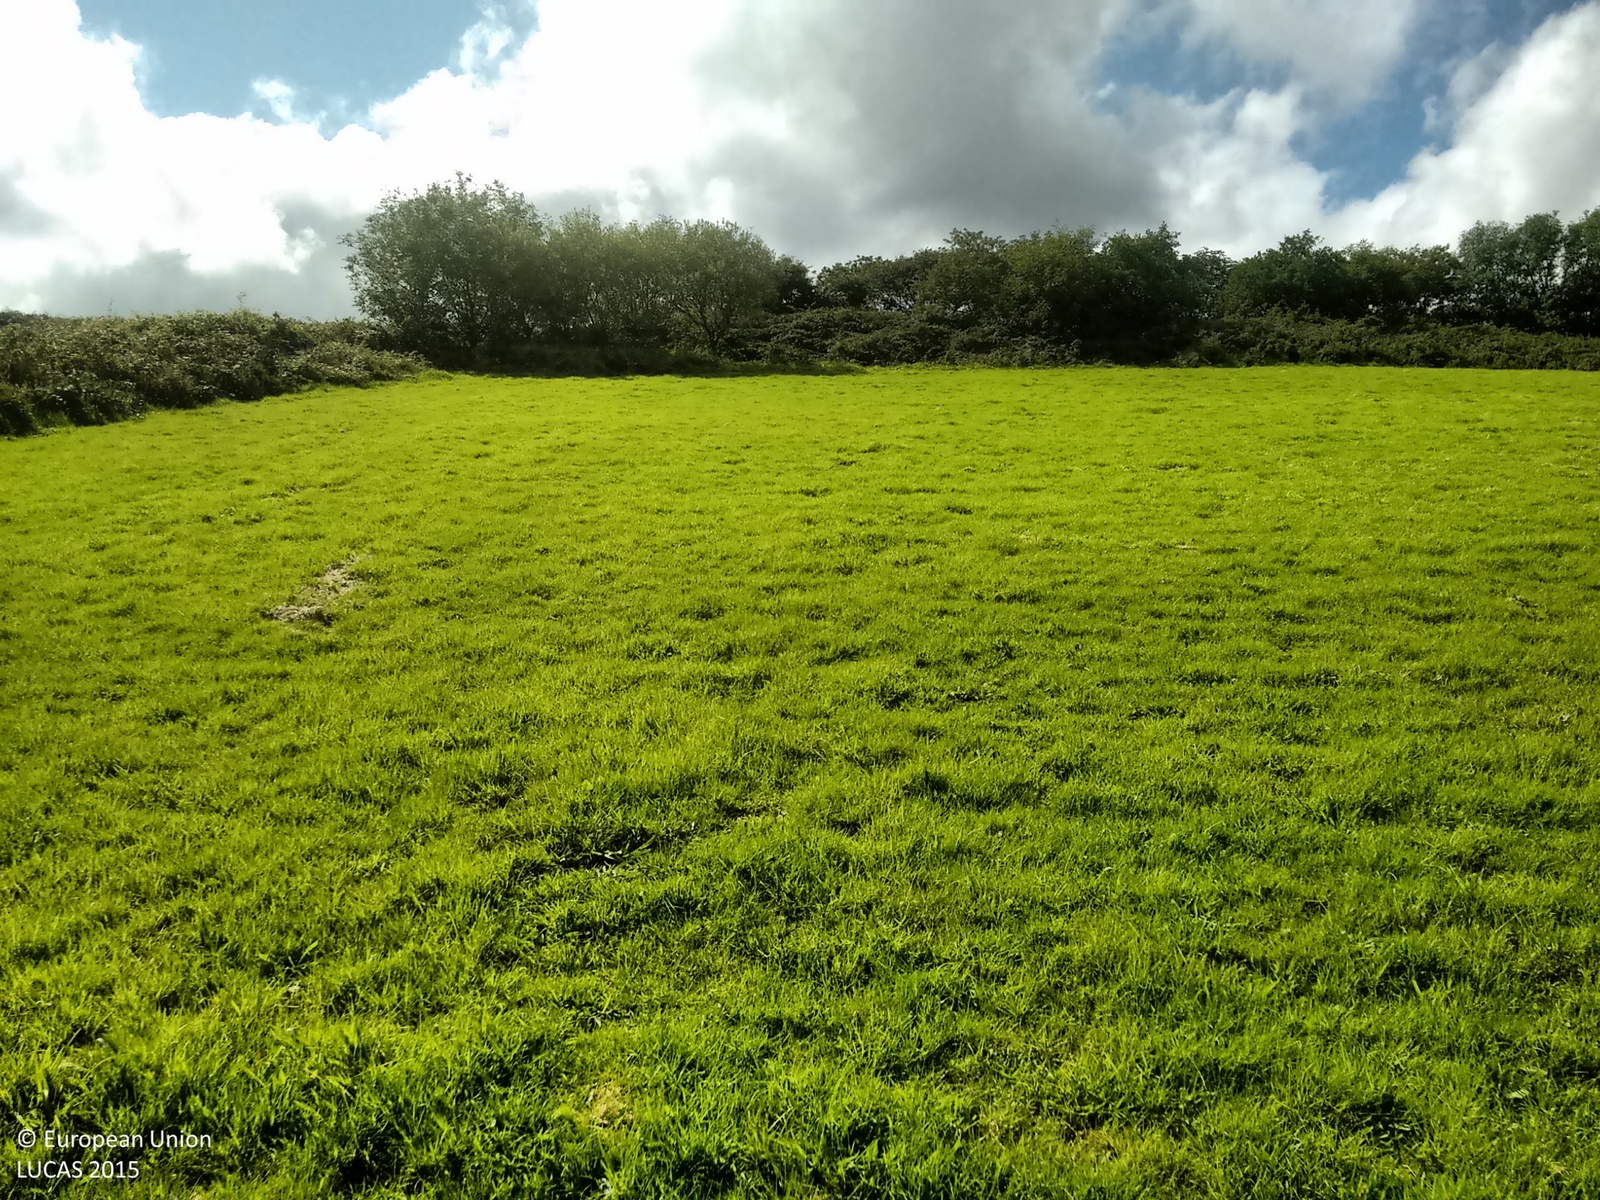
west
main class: Grassland
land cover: Grassland without tree/shrub cover
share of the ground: > 75 %
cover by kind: herbaceous plants 100 %
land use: Agriculture (excluding fallow land and kitchen gardens)
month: September
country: GB
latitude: 50.1569
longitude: -5.2520
